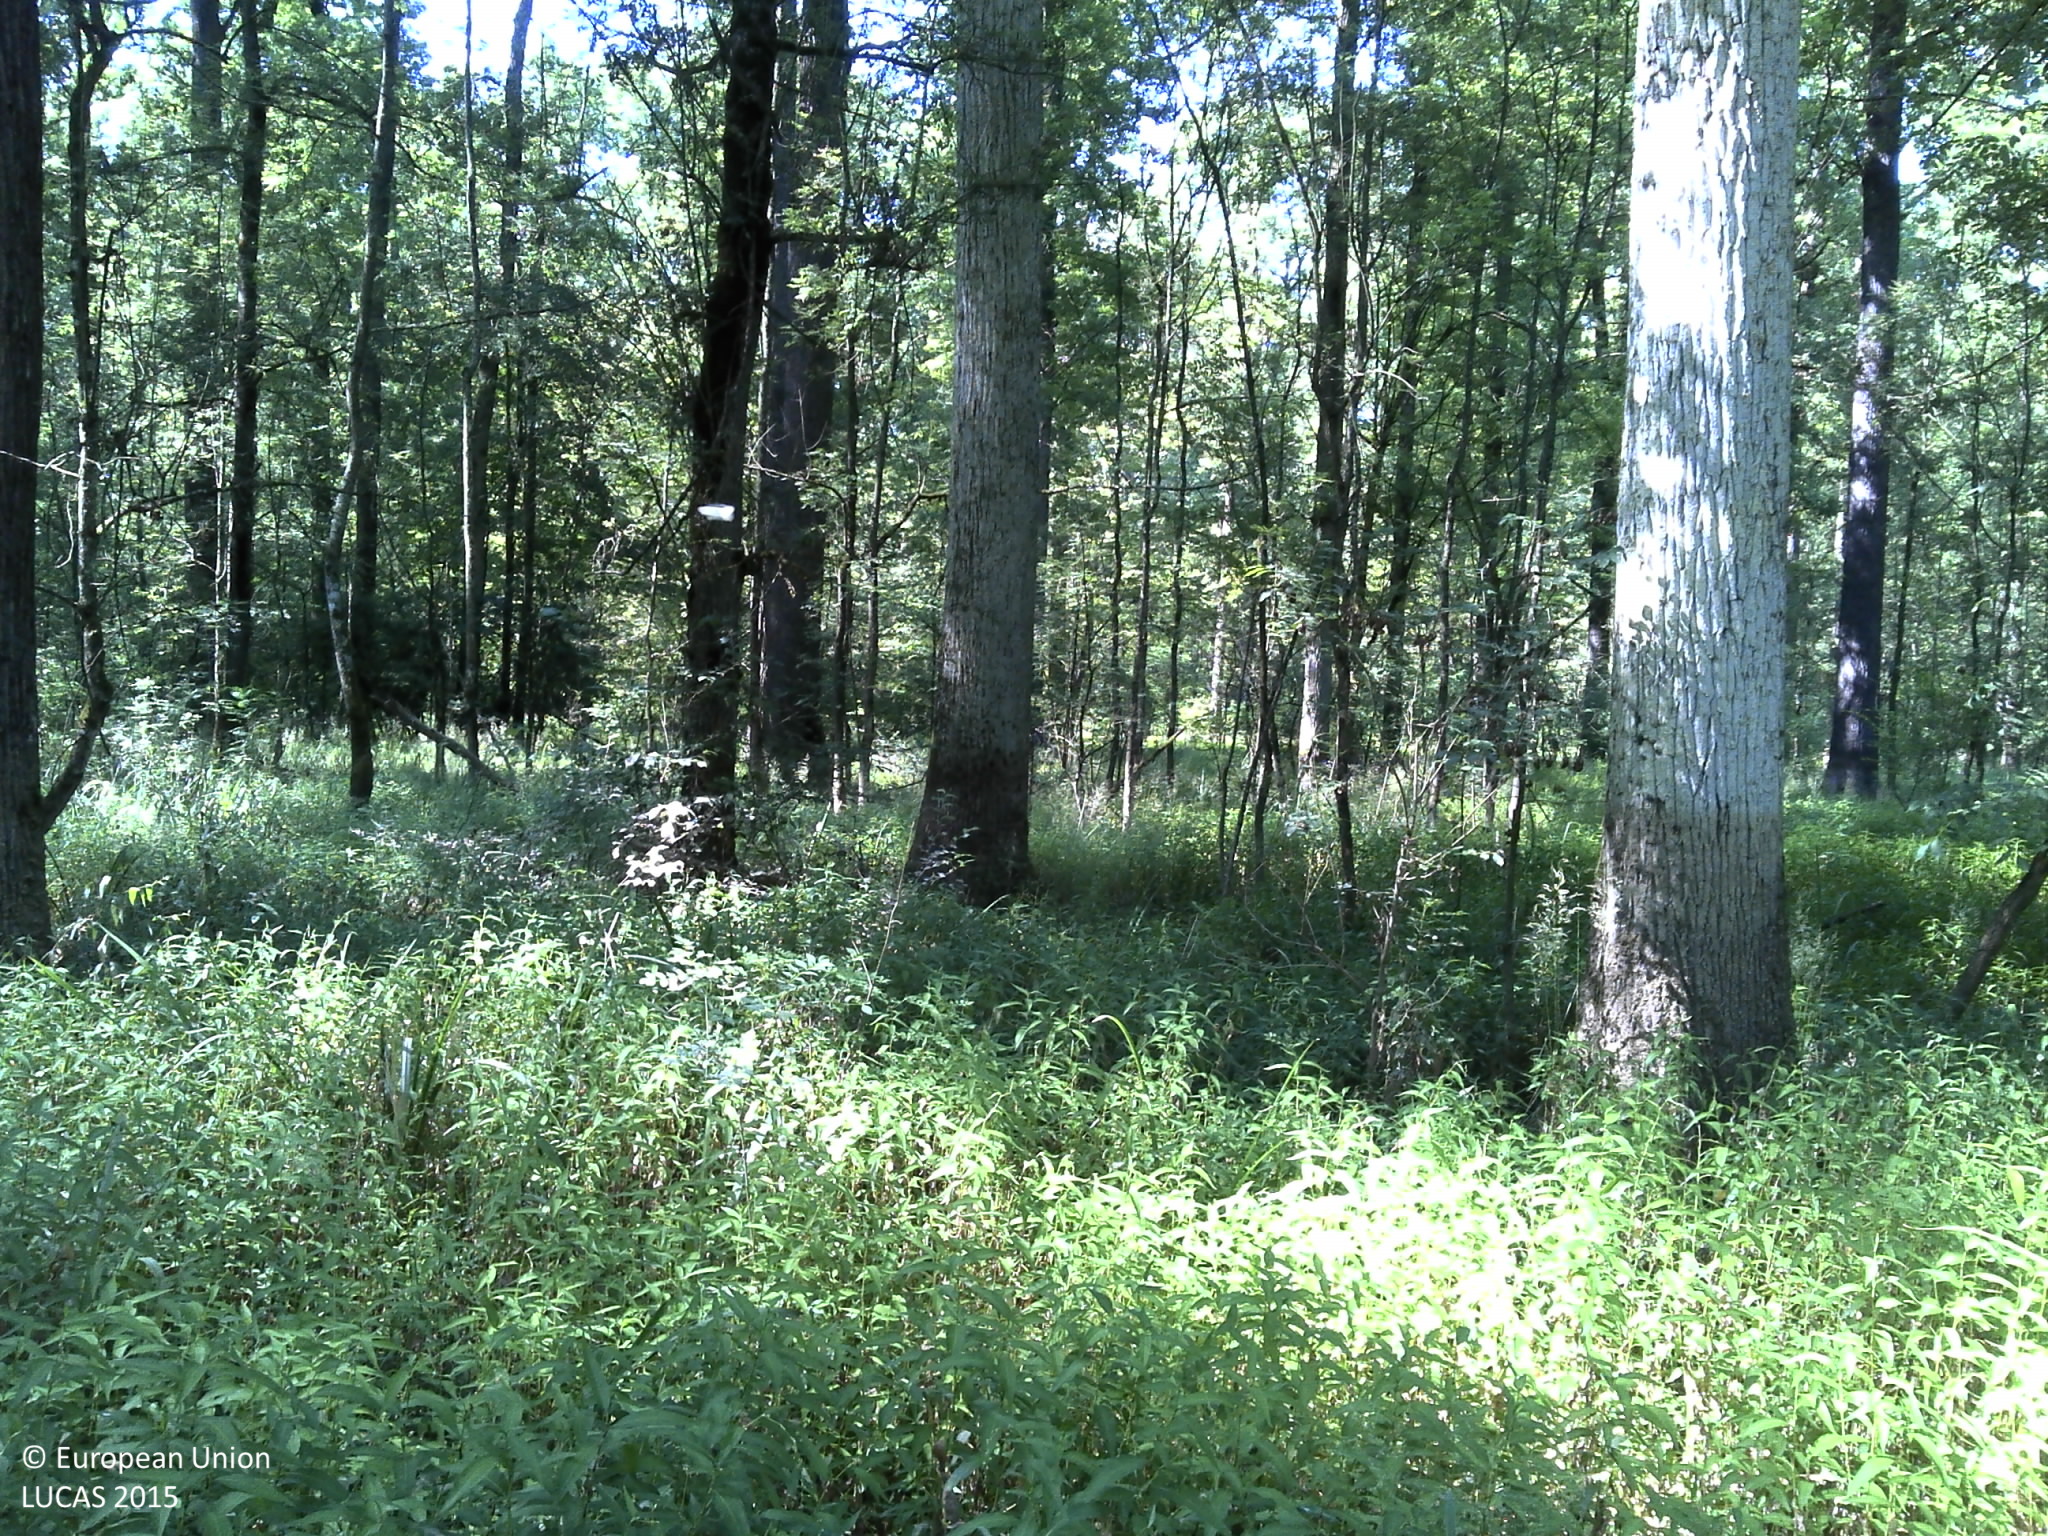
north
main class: Woodland
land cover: Broadleaved woodland
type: acidophilous oak and oak-birch forest
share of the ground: > 75 %
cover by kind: broadleaved forest trees 80 %, lichens and mosses 20 %
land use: Forestry
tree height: > 5 m
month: July
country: HR
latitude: 45.4127
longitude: 16.7838
